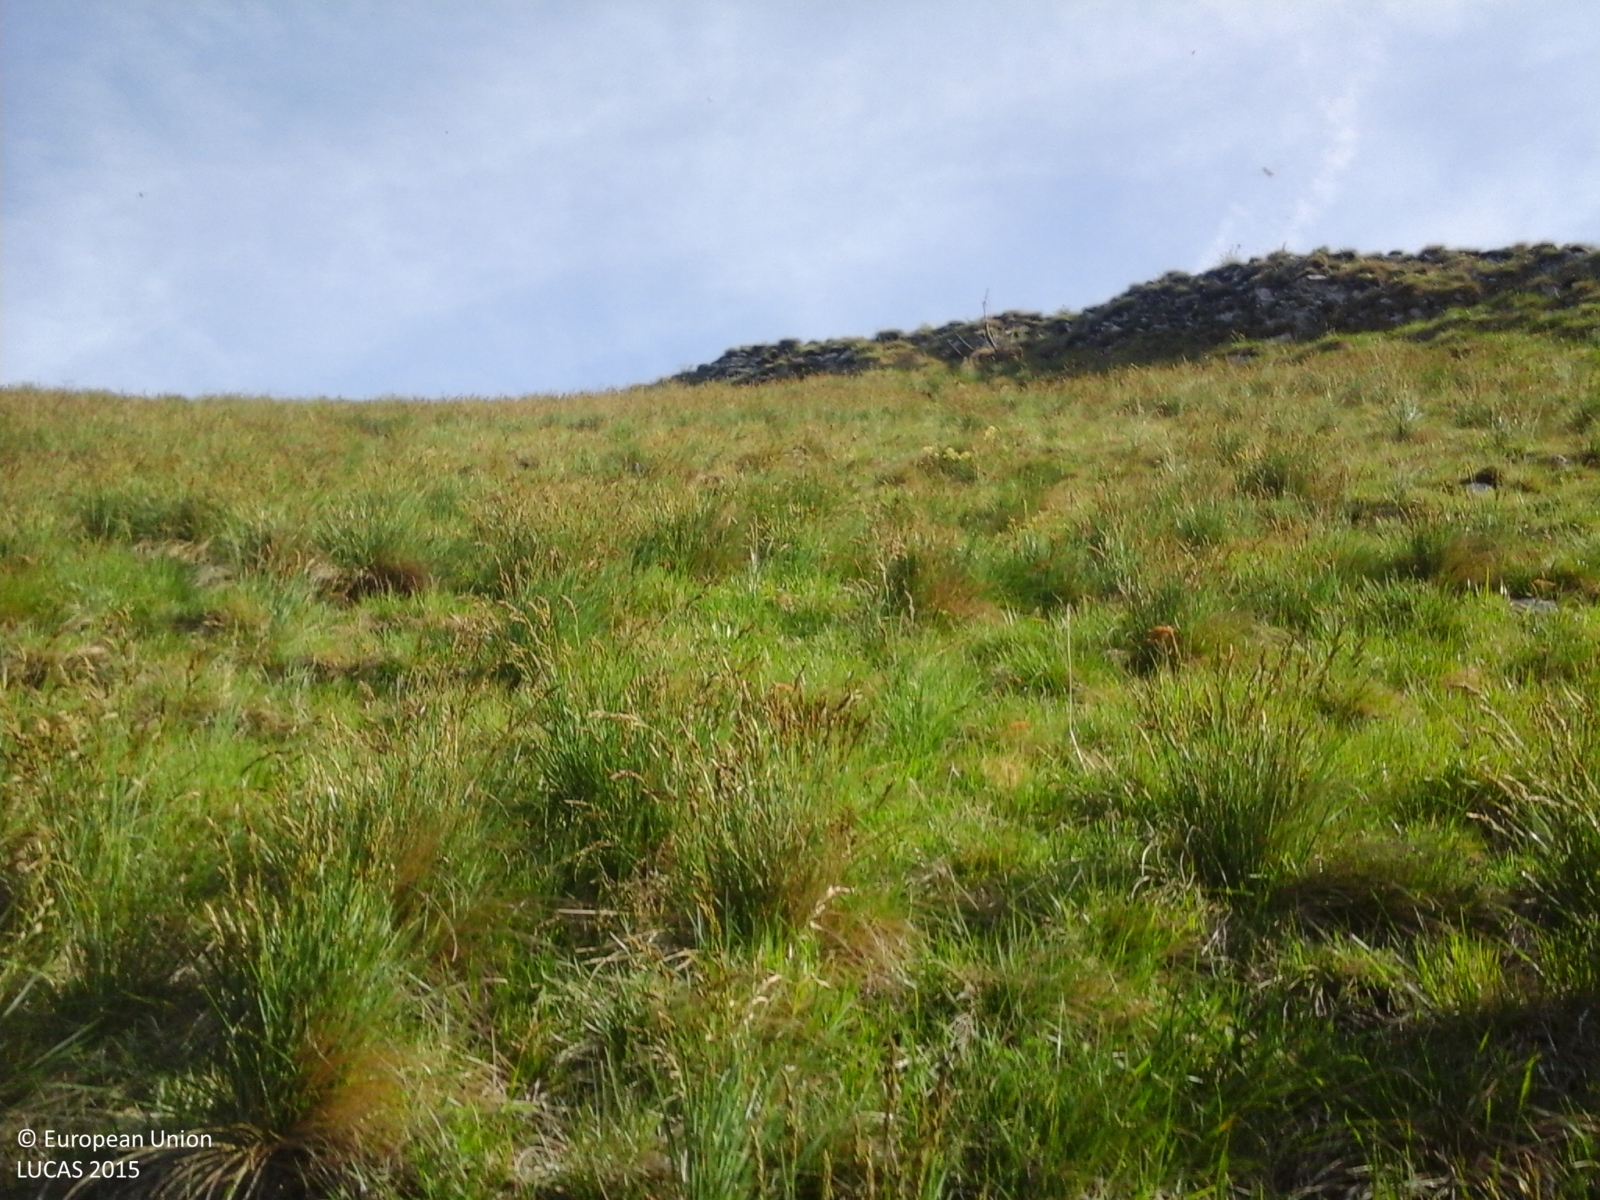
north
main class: Grassland
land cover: Grassland with sparse tree/shrub cover
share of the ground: > 75 %
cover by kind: herbaceous plants 90 %, coniferous forest trees 5 %, shrubs 5 %
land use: Agriculture (excluding fallow land and kitchen gardens)
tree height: > 5 m
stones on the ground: < 10 %
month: May
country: IT
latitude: 45.8092
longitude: 10.5782
